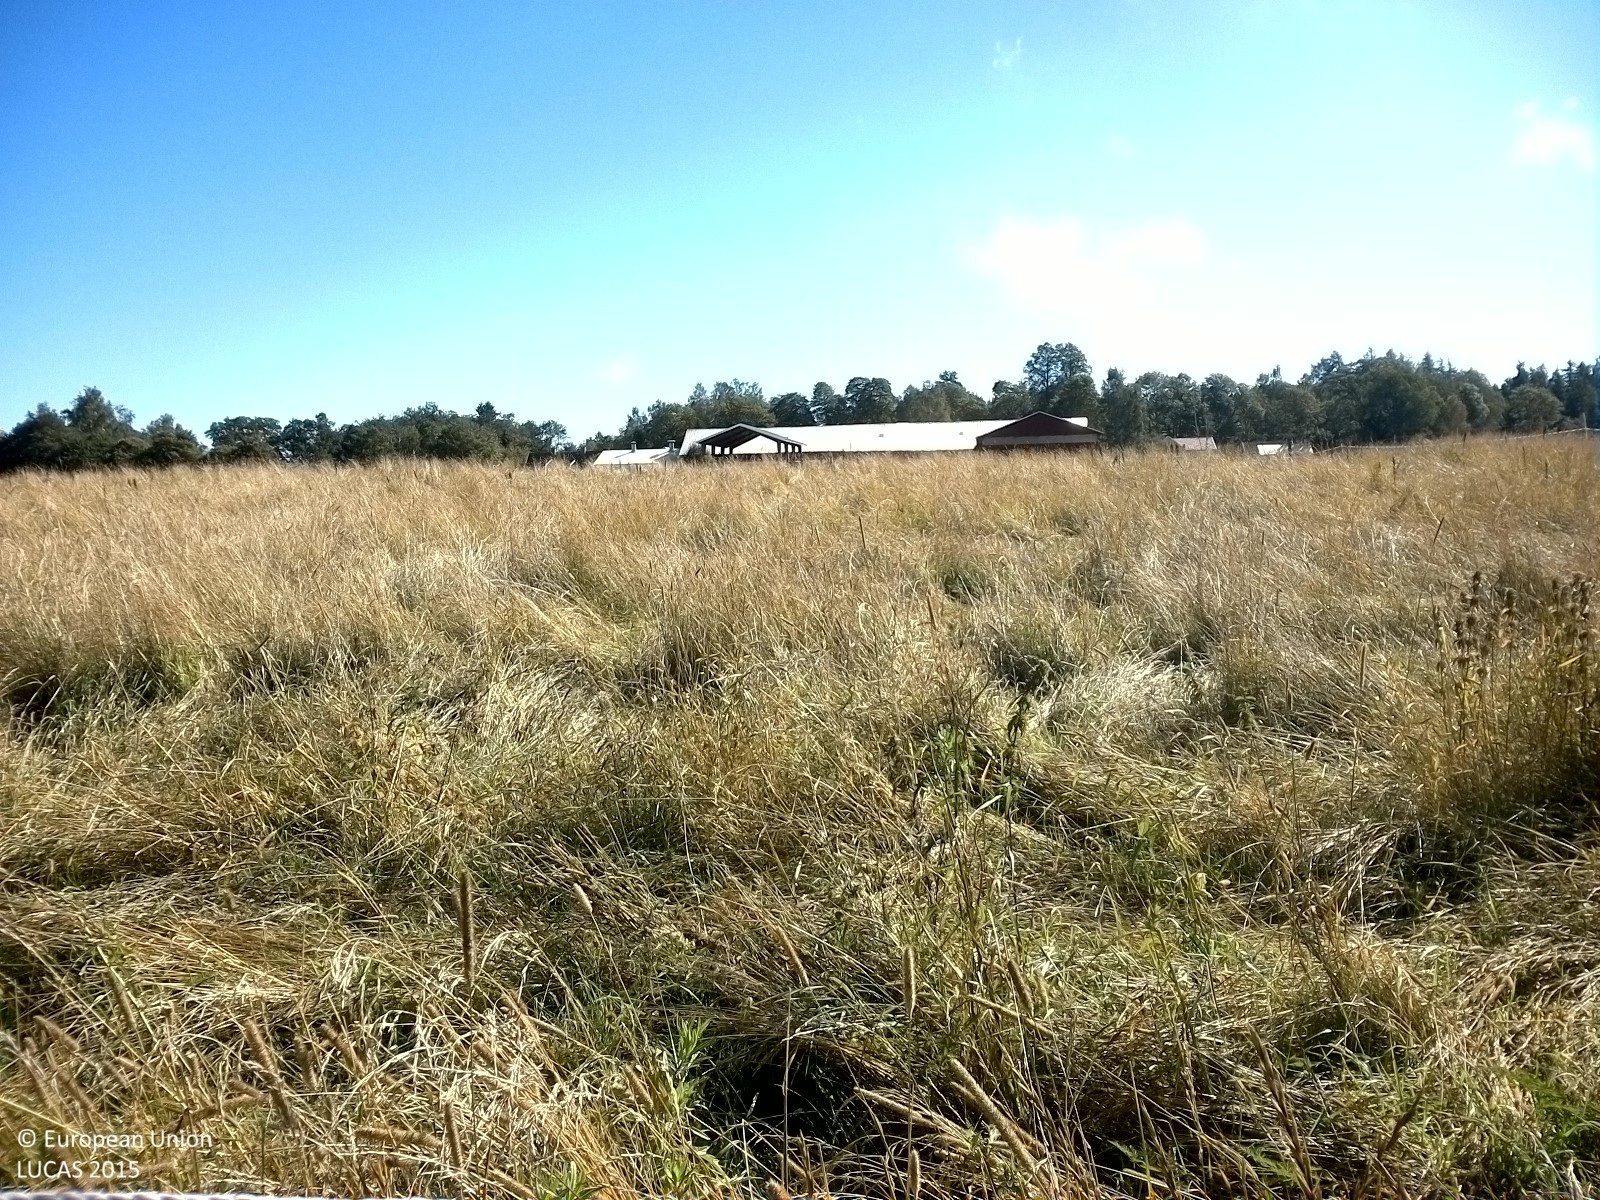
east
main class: Grassland
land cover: Grassland without tree/shrub cover
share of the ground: > 75 %
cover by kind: herbaceous plants 100 %
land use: Agriculture (excluding fallow land and kitchen gardens)
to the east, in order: Grassland without tree/shrub cover; Fences; Spontaneously vegetated surfaces; Artificial constructions in urban areas
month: August
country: SE
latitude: 59.3678
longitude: 15.0764
